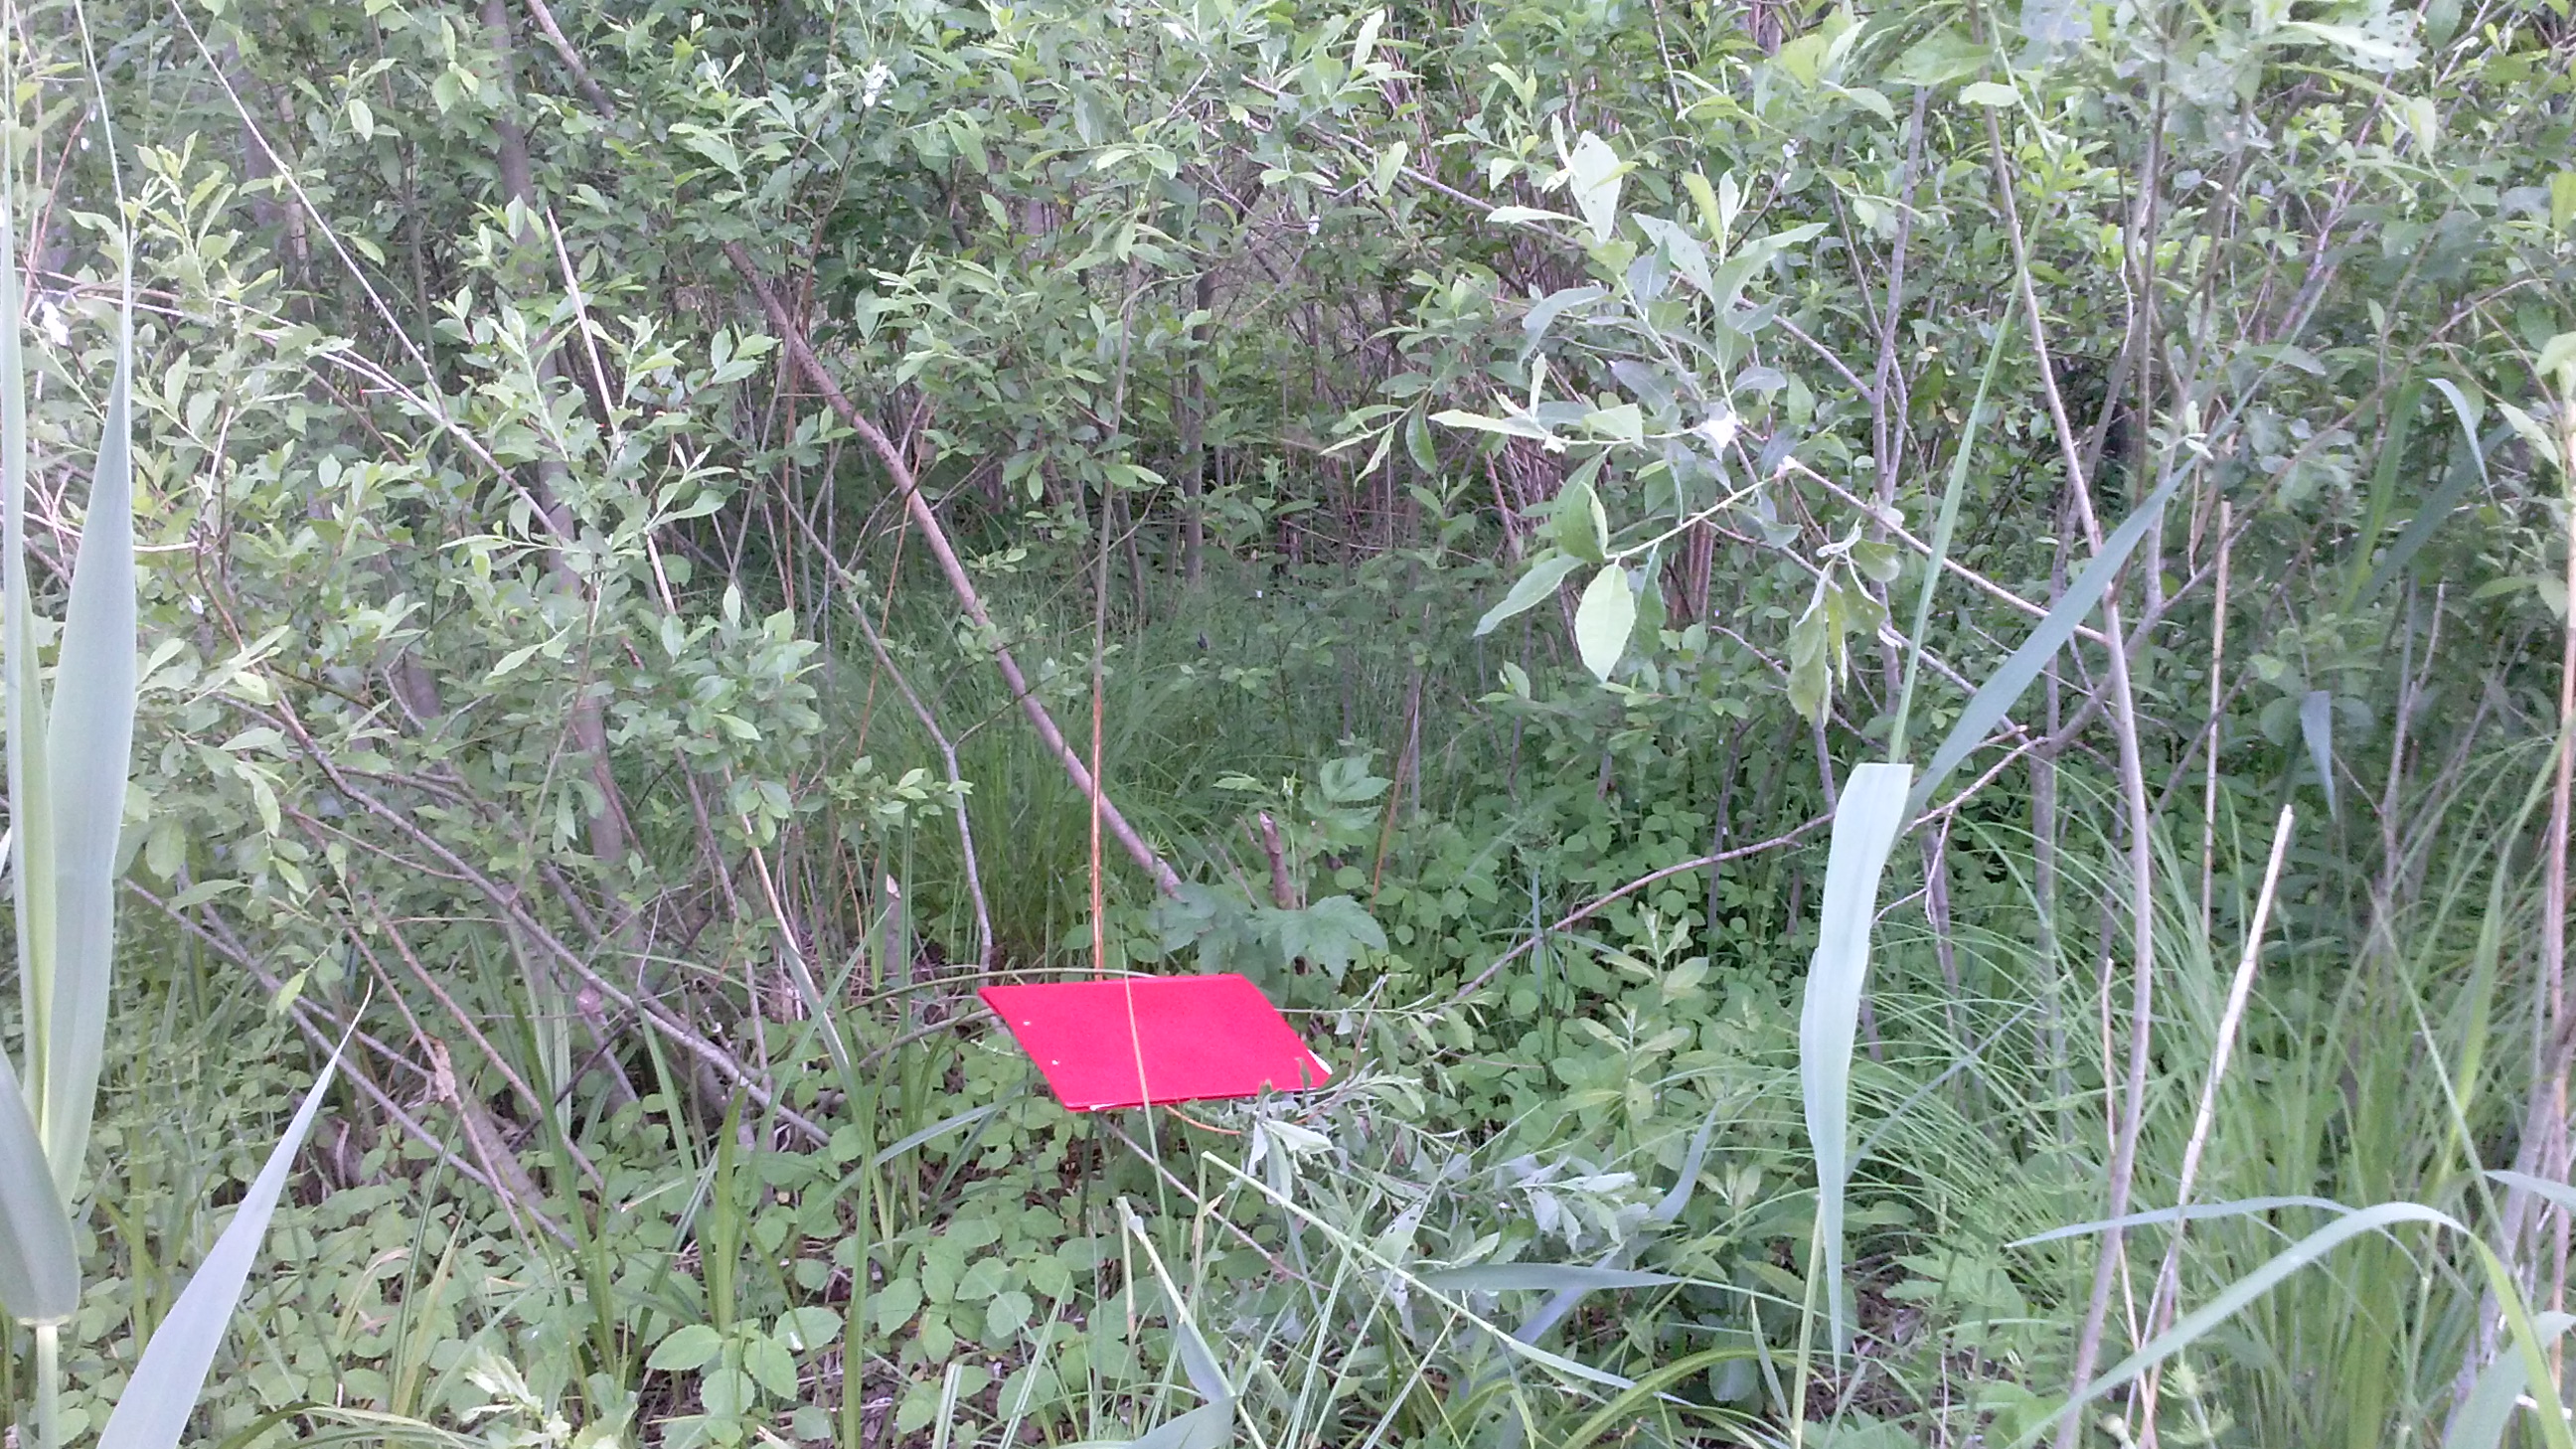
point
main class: Shrubland
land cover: Shrubland without tree cover
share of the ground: > 75 %
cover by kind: shrubs 80 %, herbaceous plants 20 %
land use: Semi-natural and natural areas not in use
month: June
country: LV
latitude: 56.4138
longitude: 27.6075
